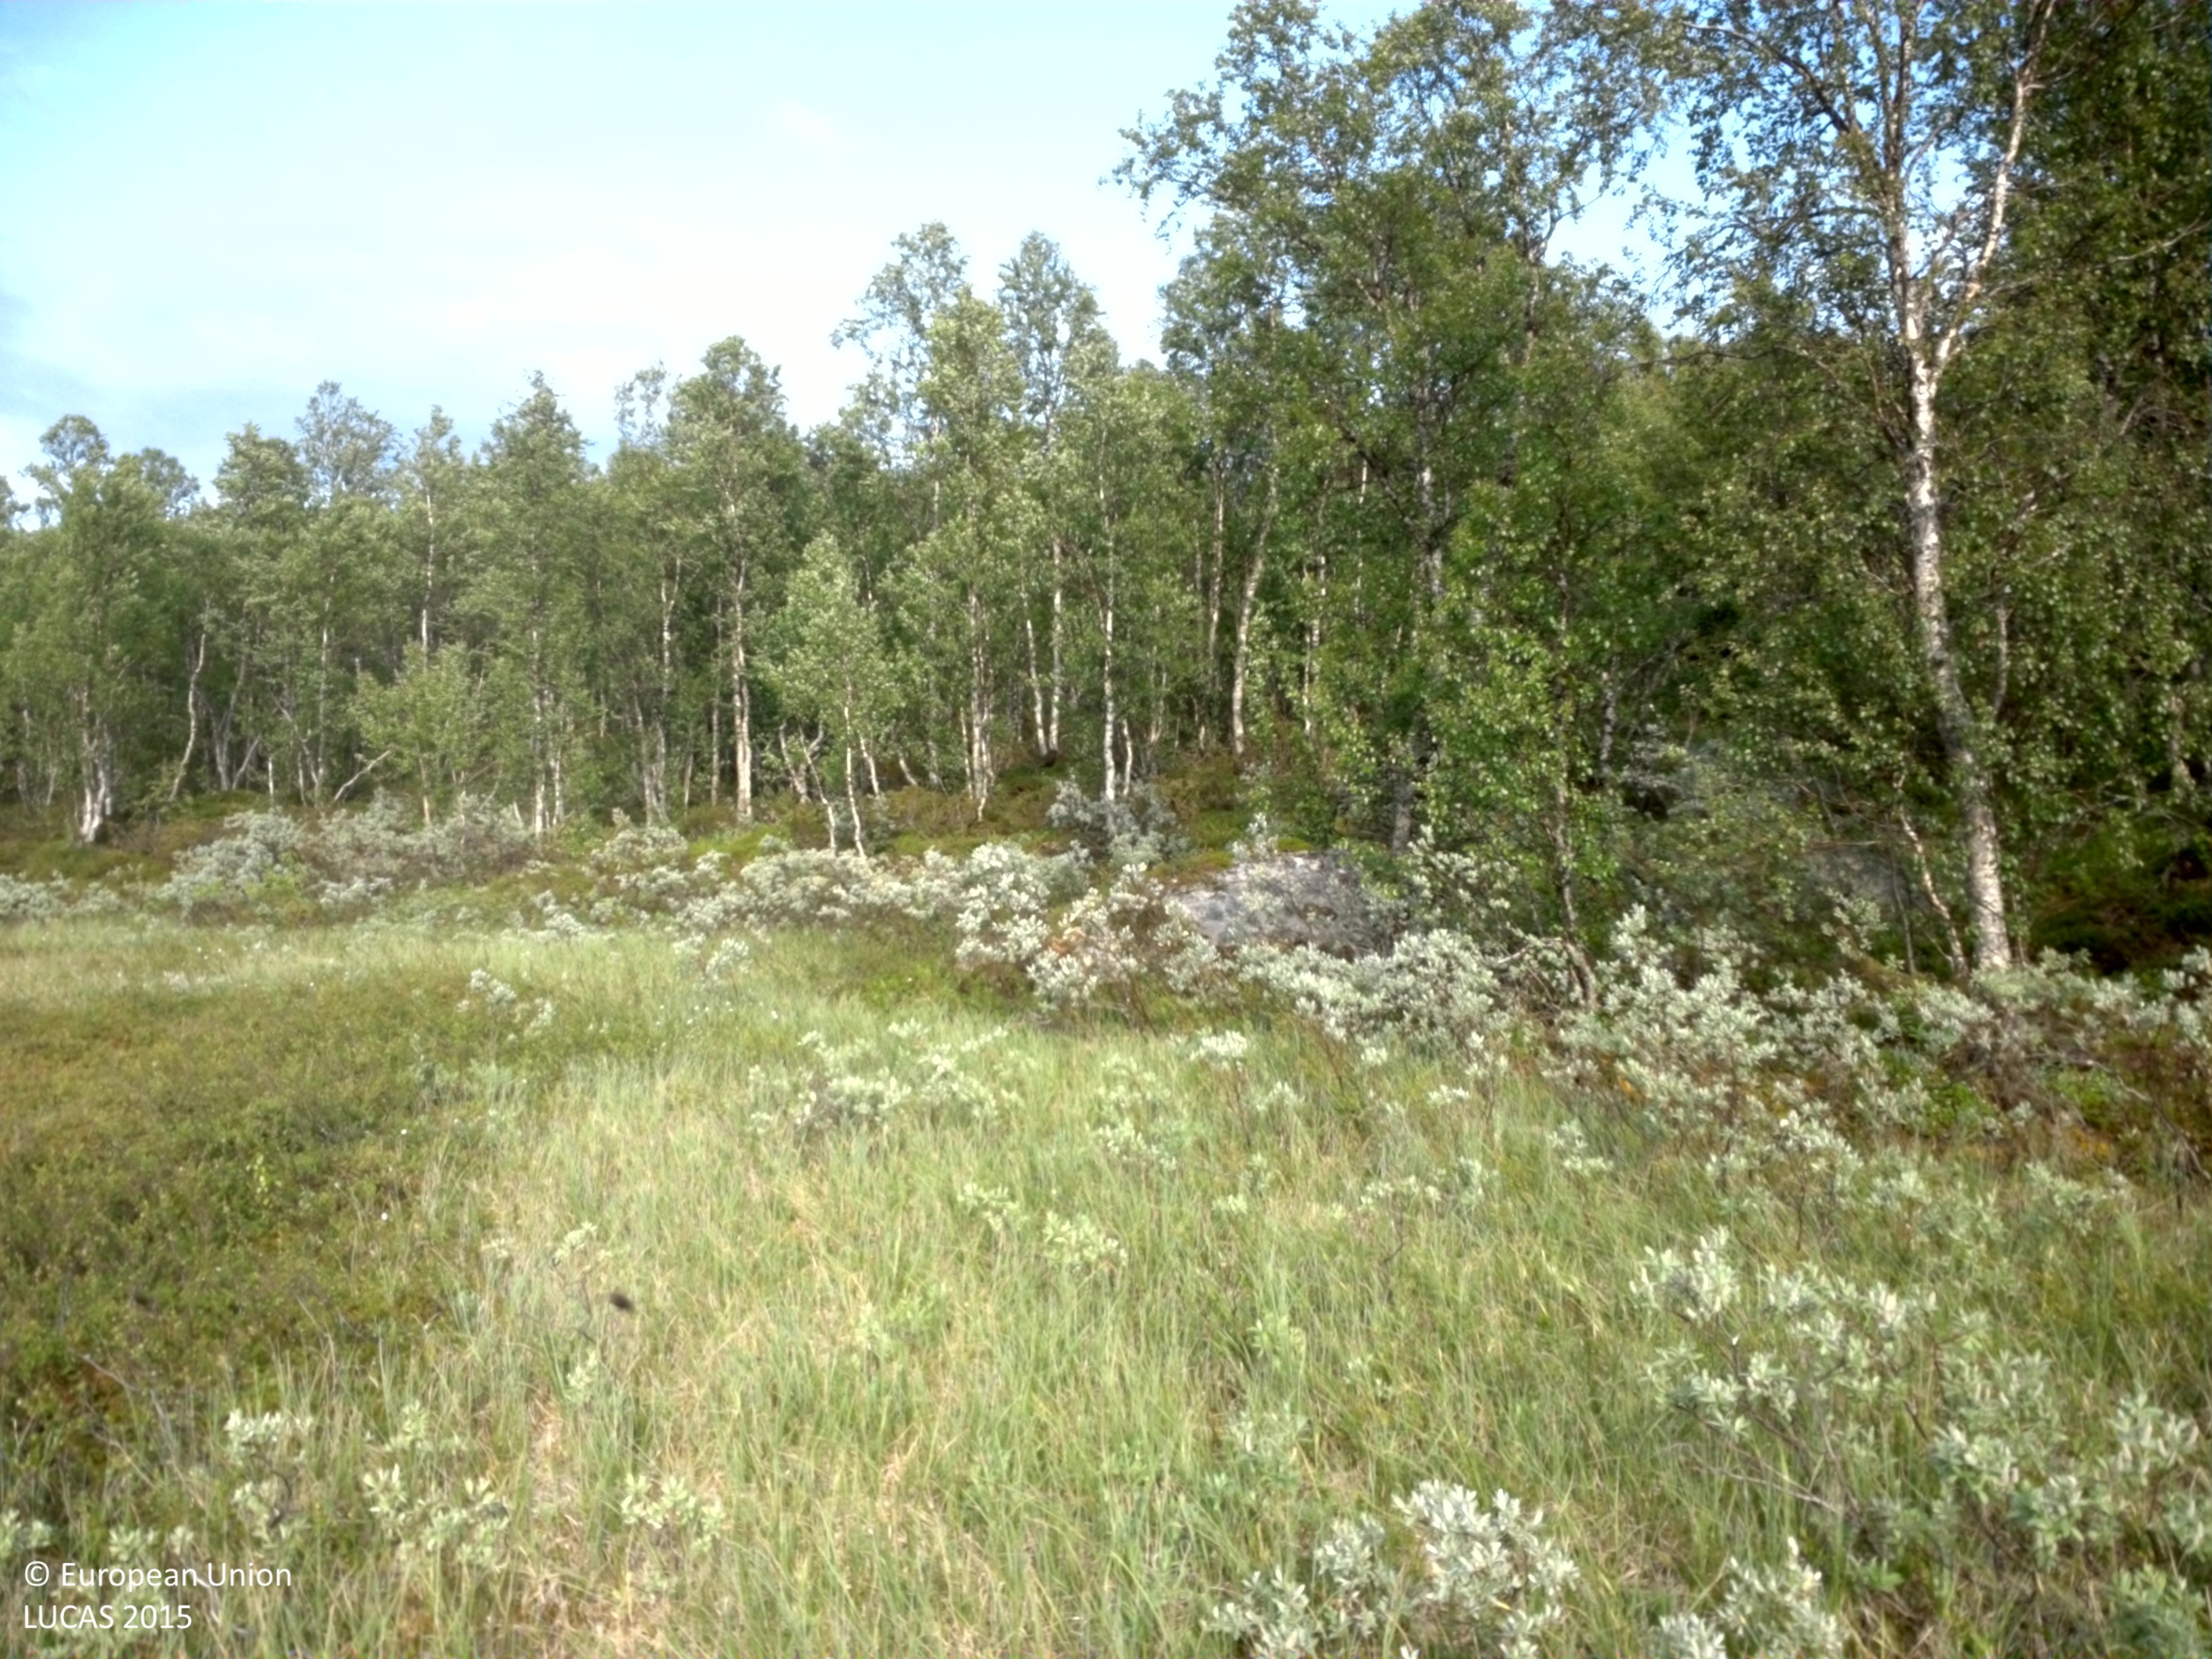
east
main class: Shrubland
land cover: Shrubland without tree cover
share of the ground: 25 - 50 %
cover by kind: herbaceous plants 55 %, shrubs 25 %, lichens and mosses 20 %
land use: Semi-natural and natural areas not in use
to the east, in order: Shrubland without tree cover; Broadleaved woodland
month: July
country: SE
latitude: 65.7540
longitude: 15.4411
